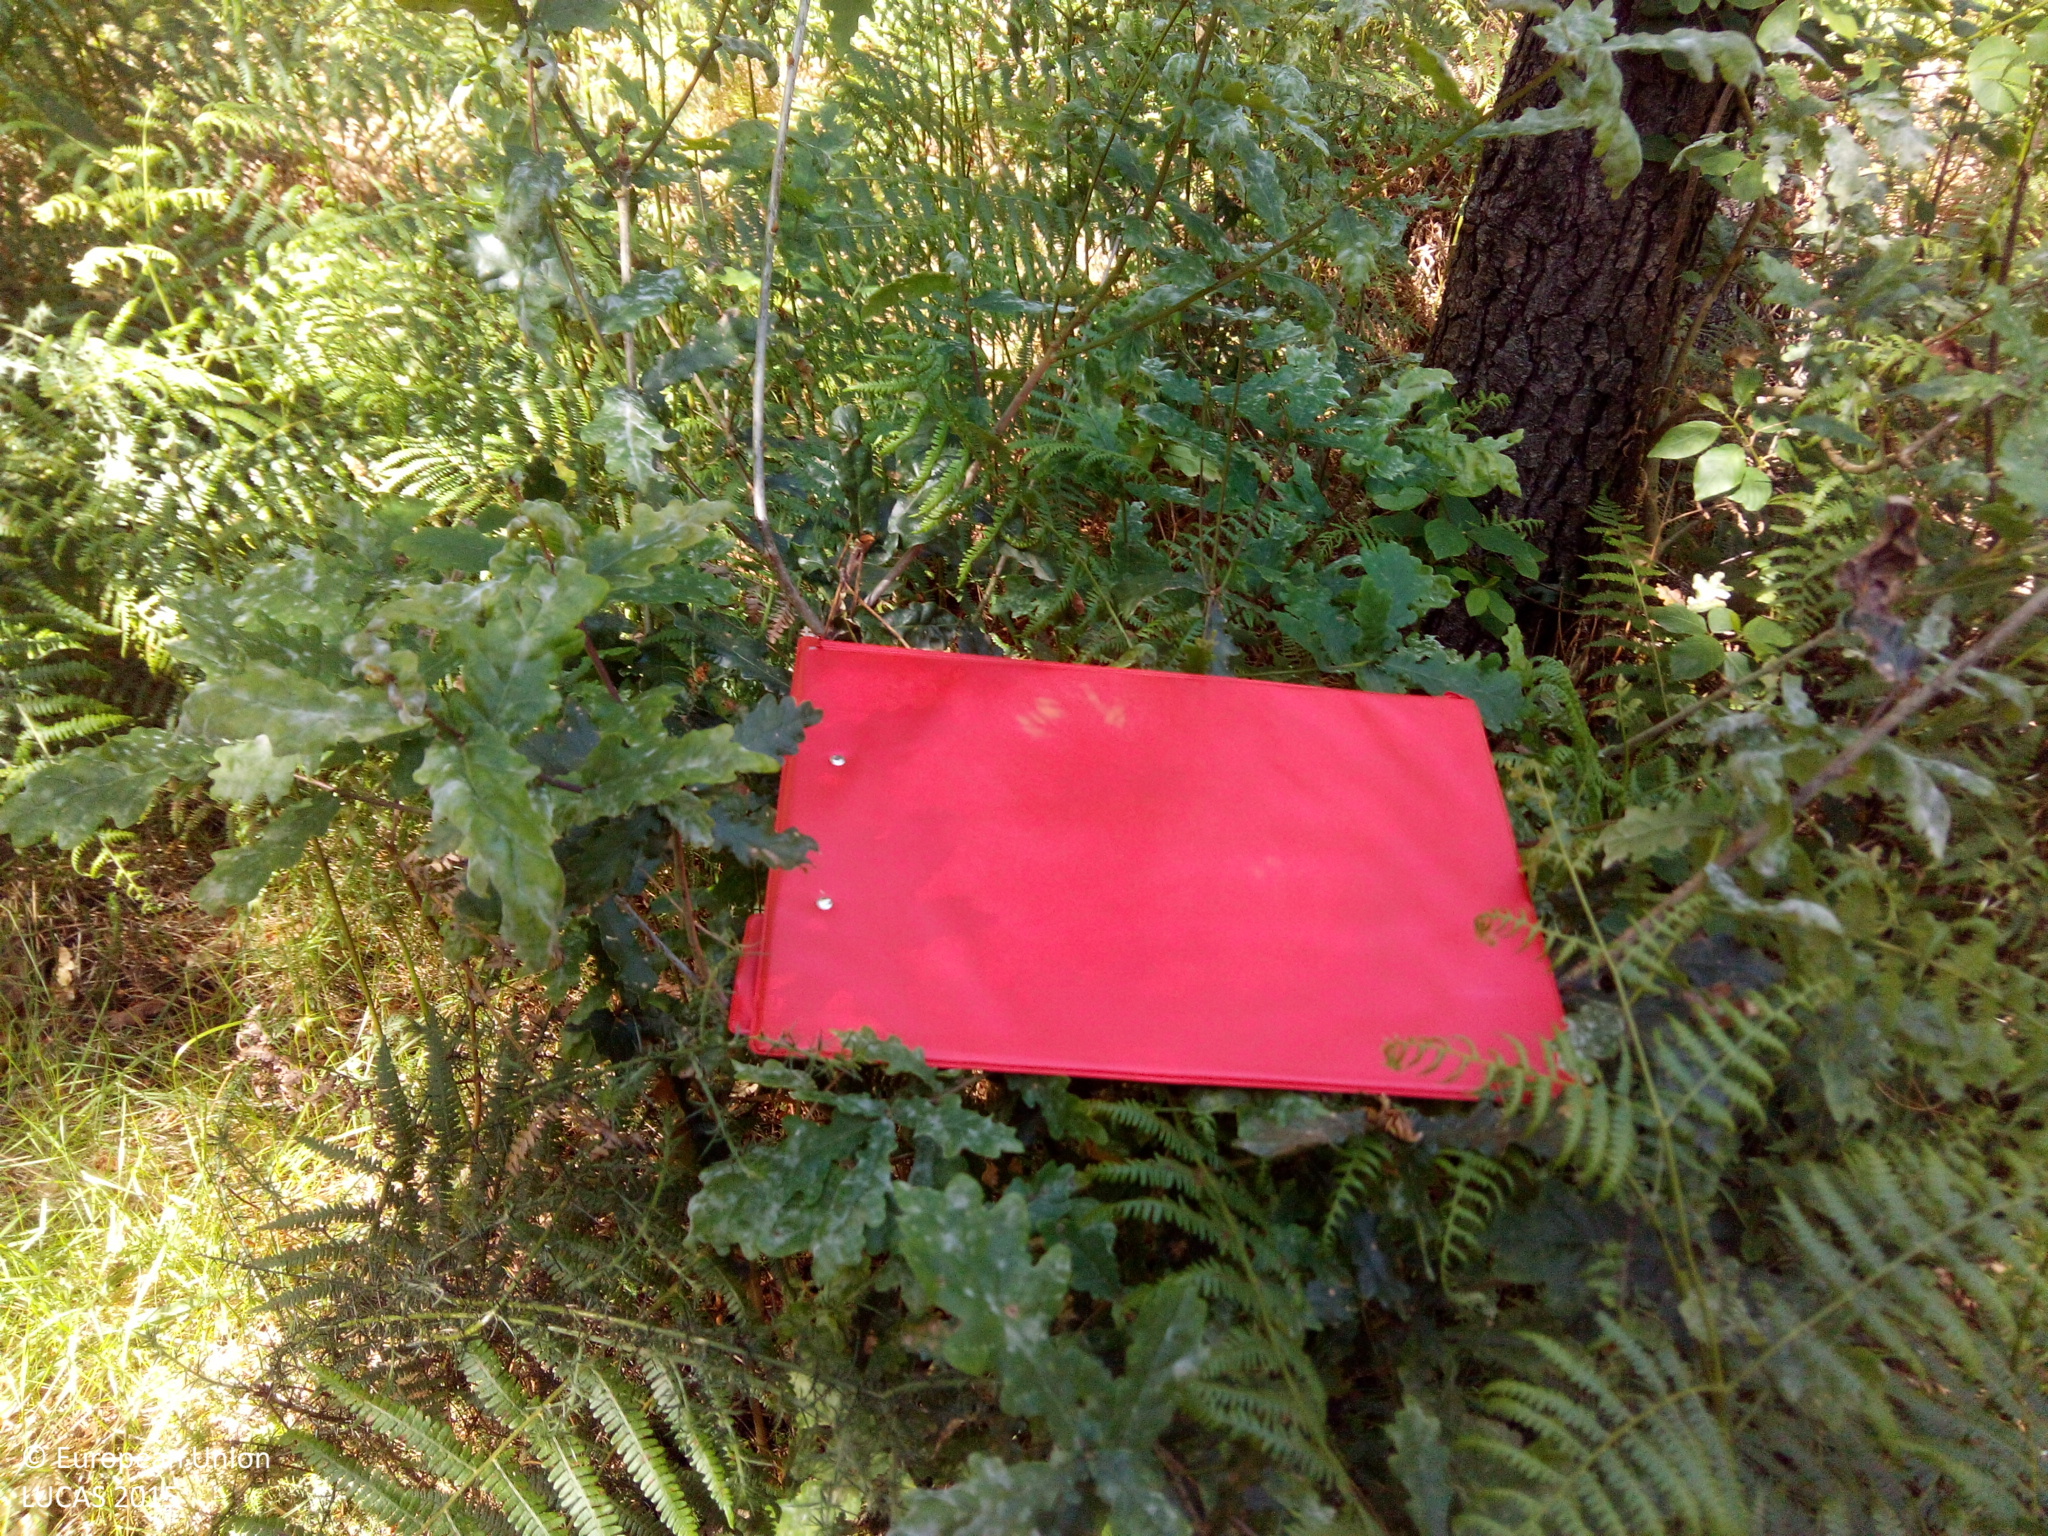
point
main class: Woodland
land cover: Pine dominated coniferous woodland
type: hemiboreal forest and nemoral coniferous forest and mixed broadleaved-coniferous forest
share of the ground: > 75 %
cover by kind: coniferous forest trees 75 %, shrubs 25 %
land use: Forestry
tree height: > 5 m
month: May
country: ES
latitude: 42.6690
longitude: -8.9918
